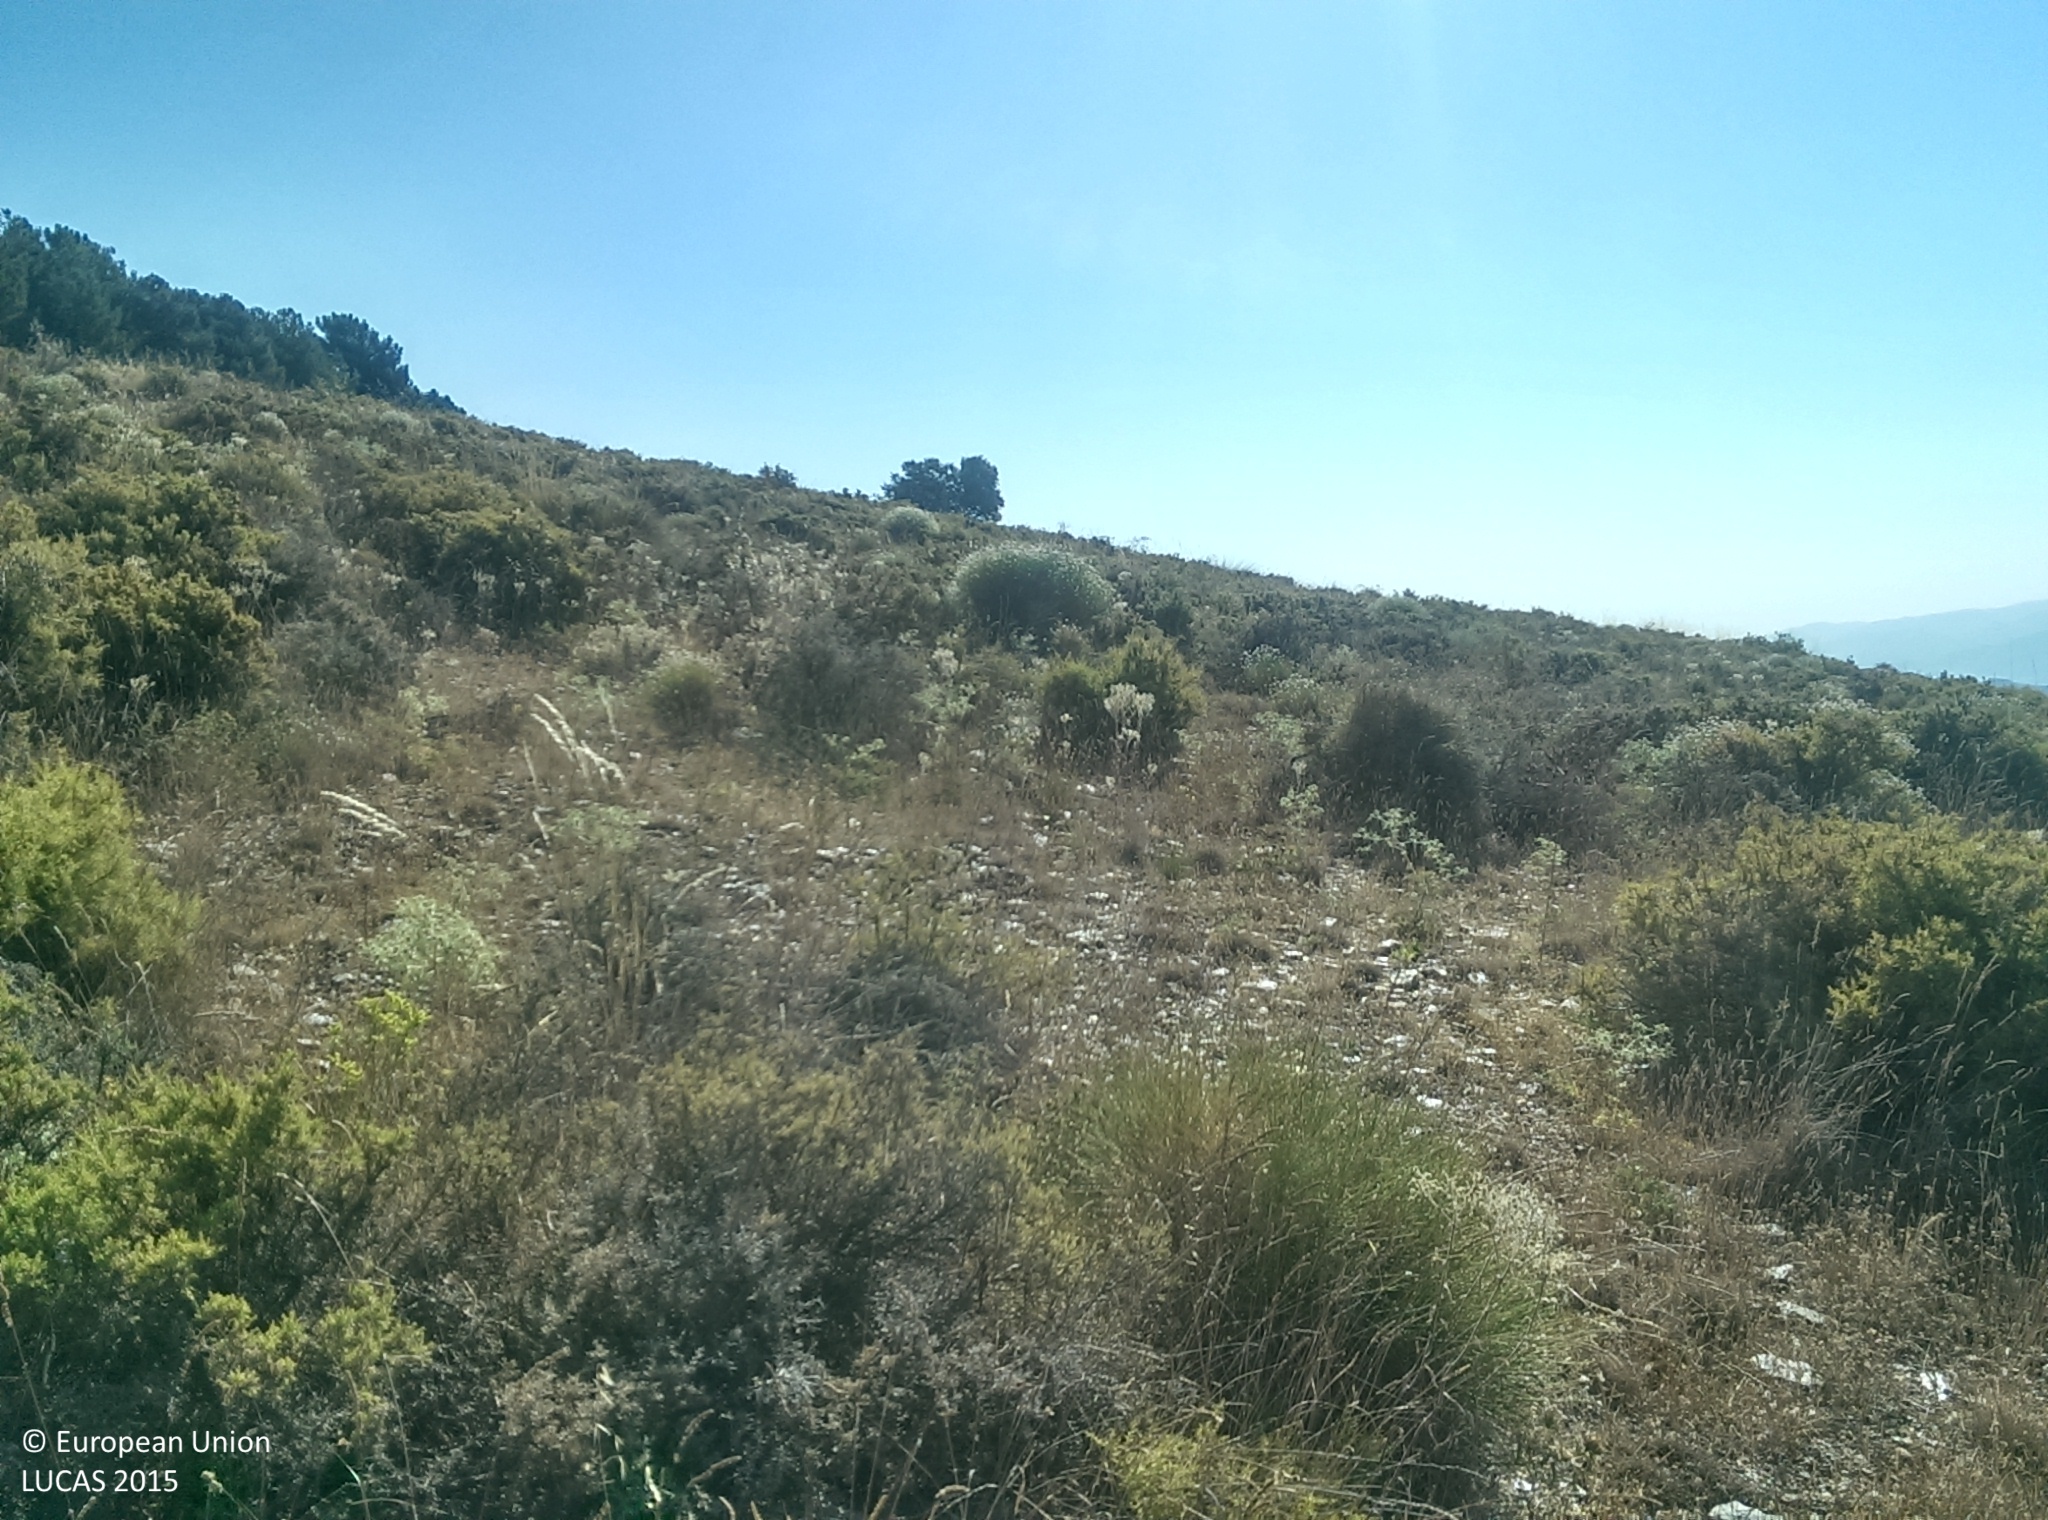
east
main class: Shrubland
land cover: Shrubland without tree cover
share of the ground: > 75 %
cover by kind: shrubs 75 %, herbaceous plants 20 %, unconsolidated bare surface 5 %
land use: Semi-natural and natural areas not in use
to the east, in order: Shrubland without tree cover; Tracks; Pine dominated coniferous woodland
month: July
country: ES
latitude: 37.0268
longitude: -3.0554
